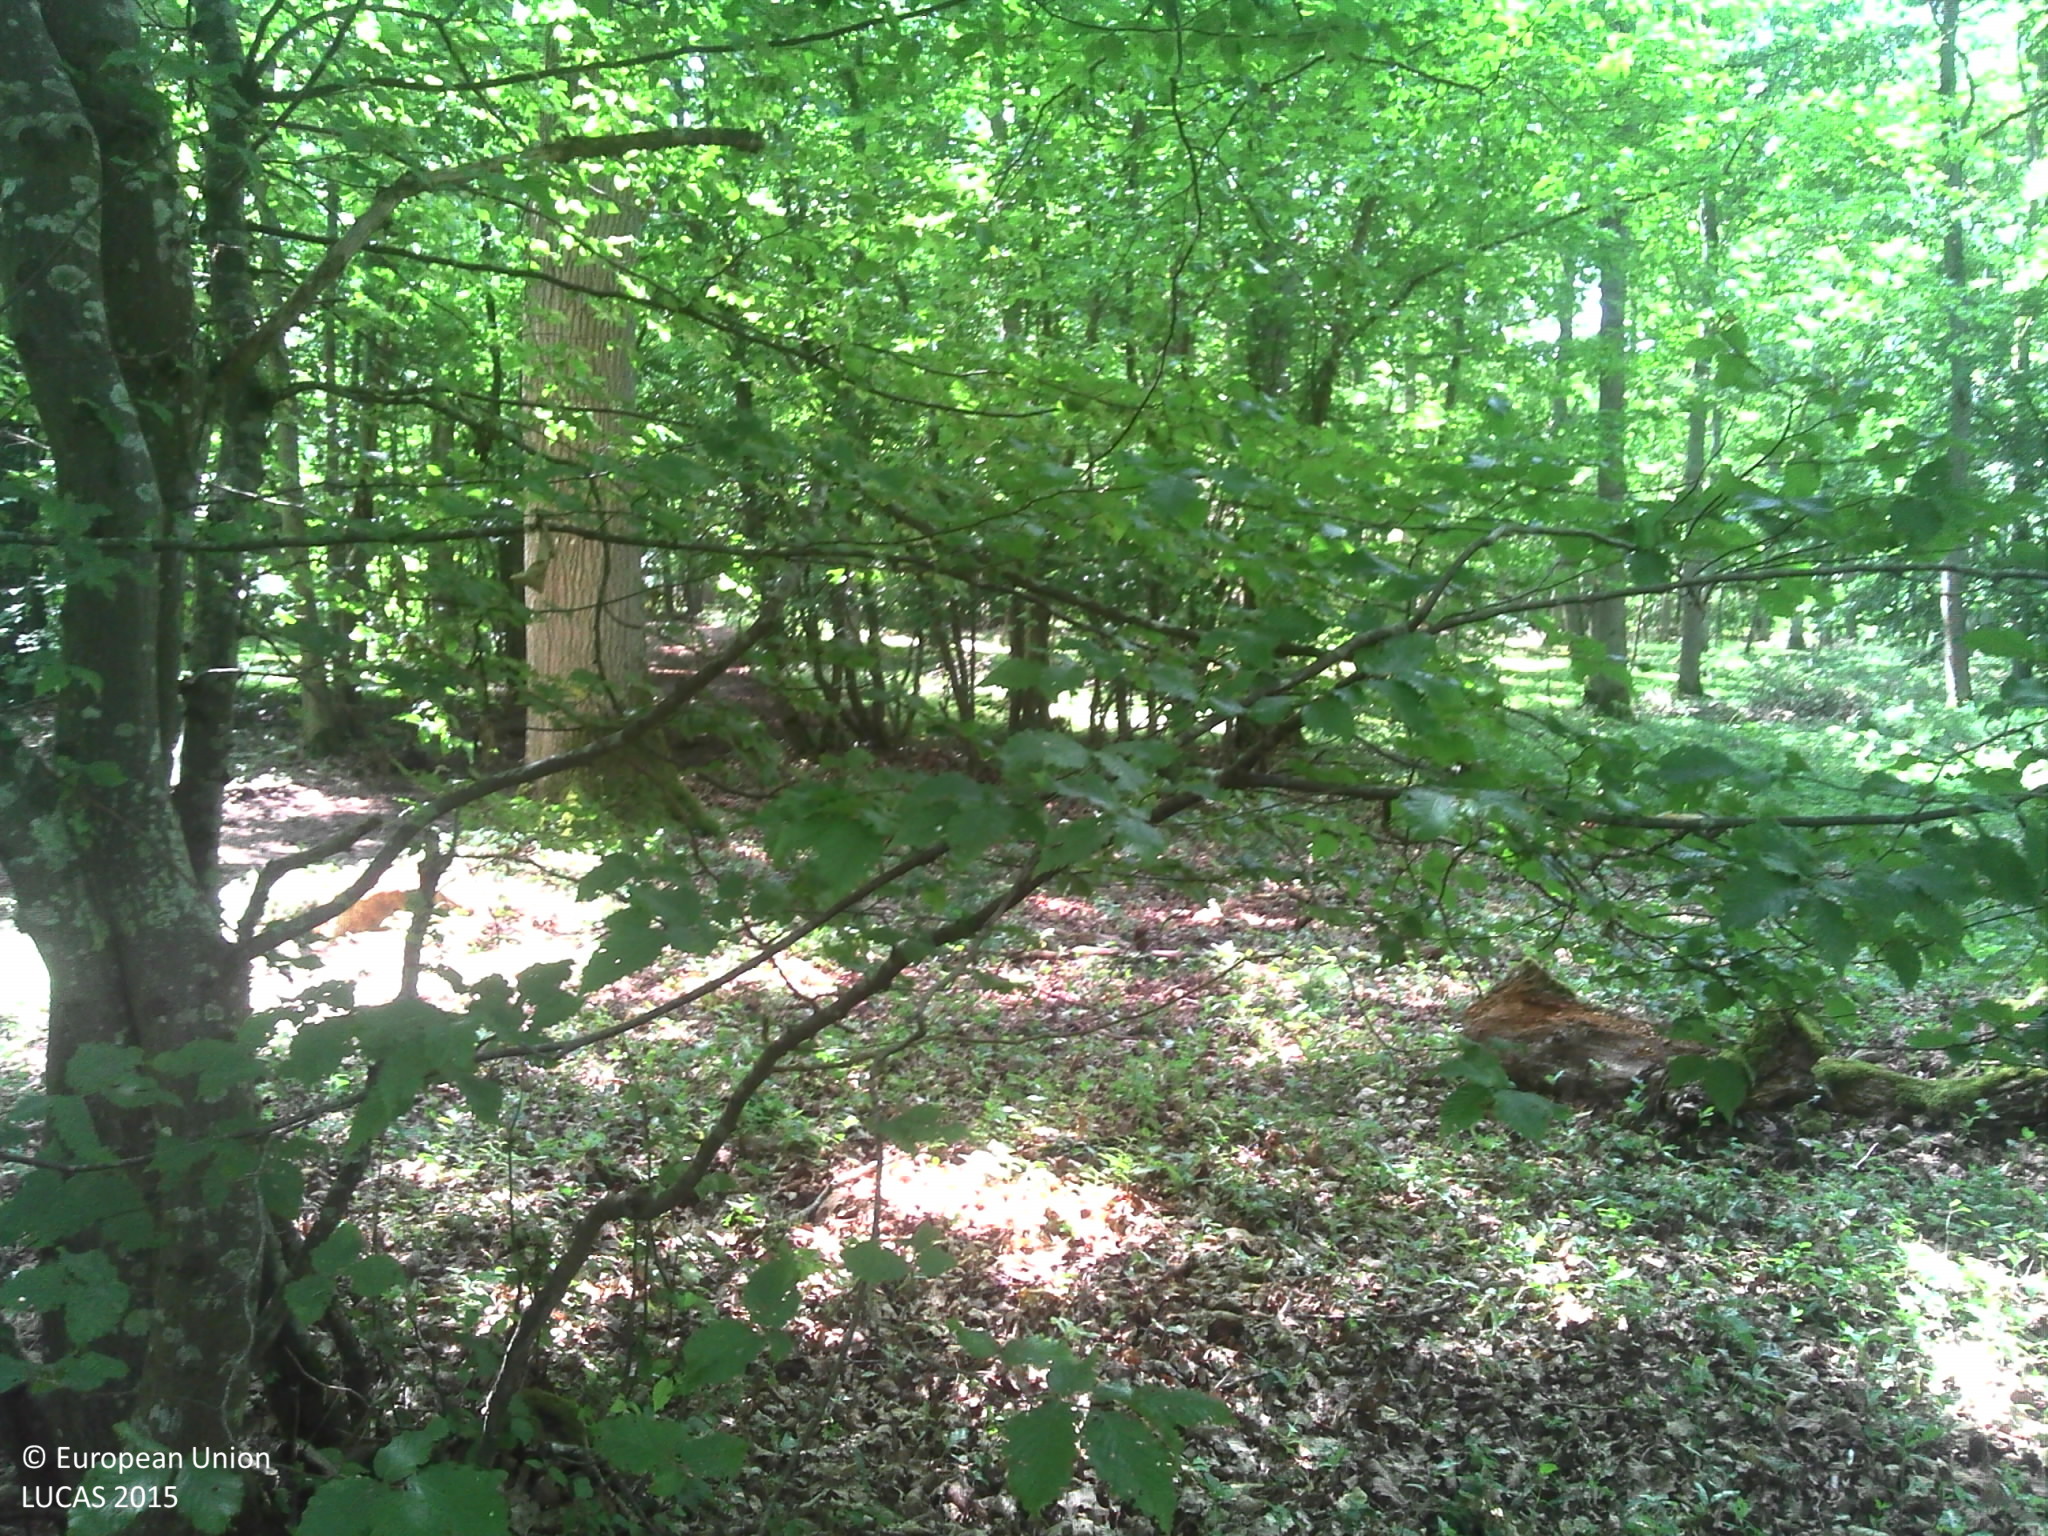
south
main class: Woodland
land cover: Broadleaved woodland
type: mesophytic deciduous forest
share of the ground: > 75 %
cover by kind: broadleaved forest trees 80 %, herbaceous plants 10 %, lichens and mosses 10 %
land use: Forestry
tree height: > 5 m
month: June
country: FR
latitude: 48.6156
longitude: 1.2318
